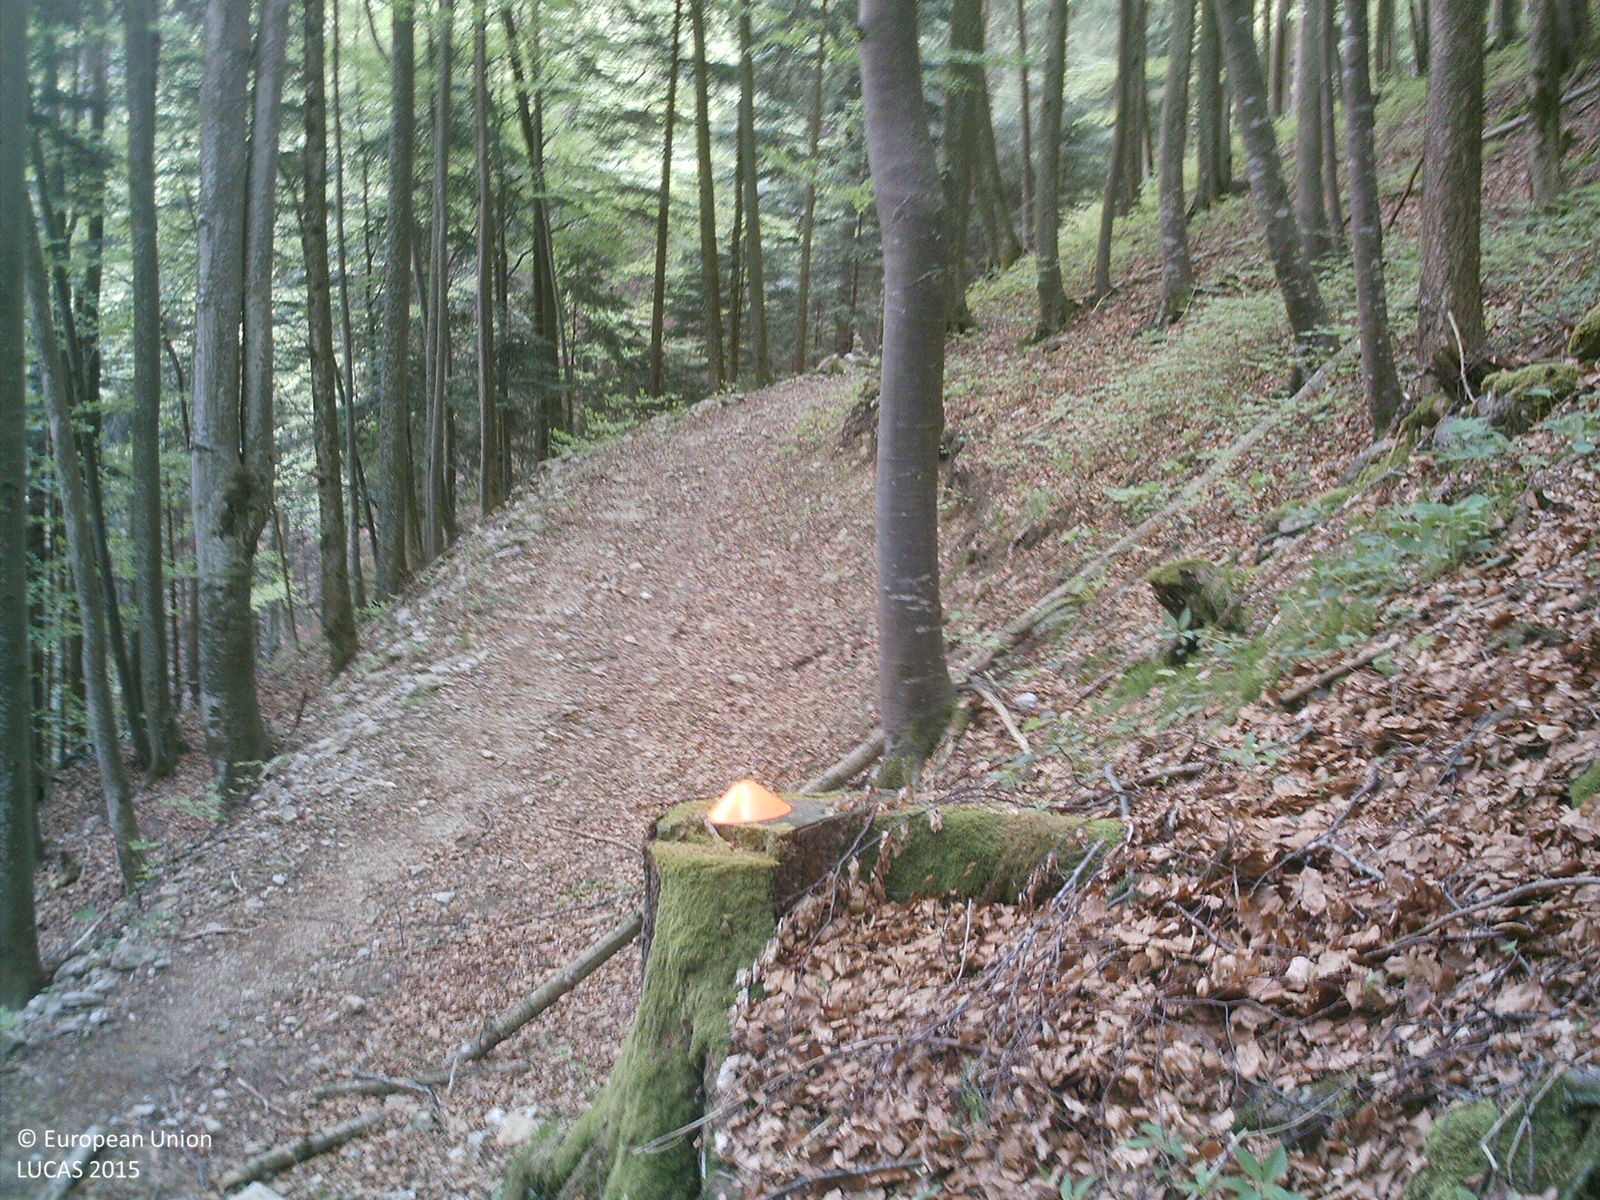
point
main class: Woodland
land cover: Other mixed woodland
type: mountainous beech forest
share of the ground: > 75 %
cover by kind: broadleaved forest trees 75 %, coniferous forest trees 25 %
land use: Forestry
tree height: > 5 m
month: May
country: AT
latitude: 47.8798
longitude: 14.0241
